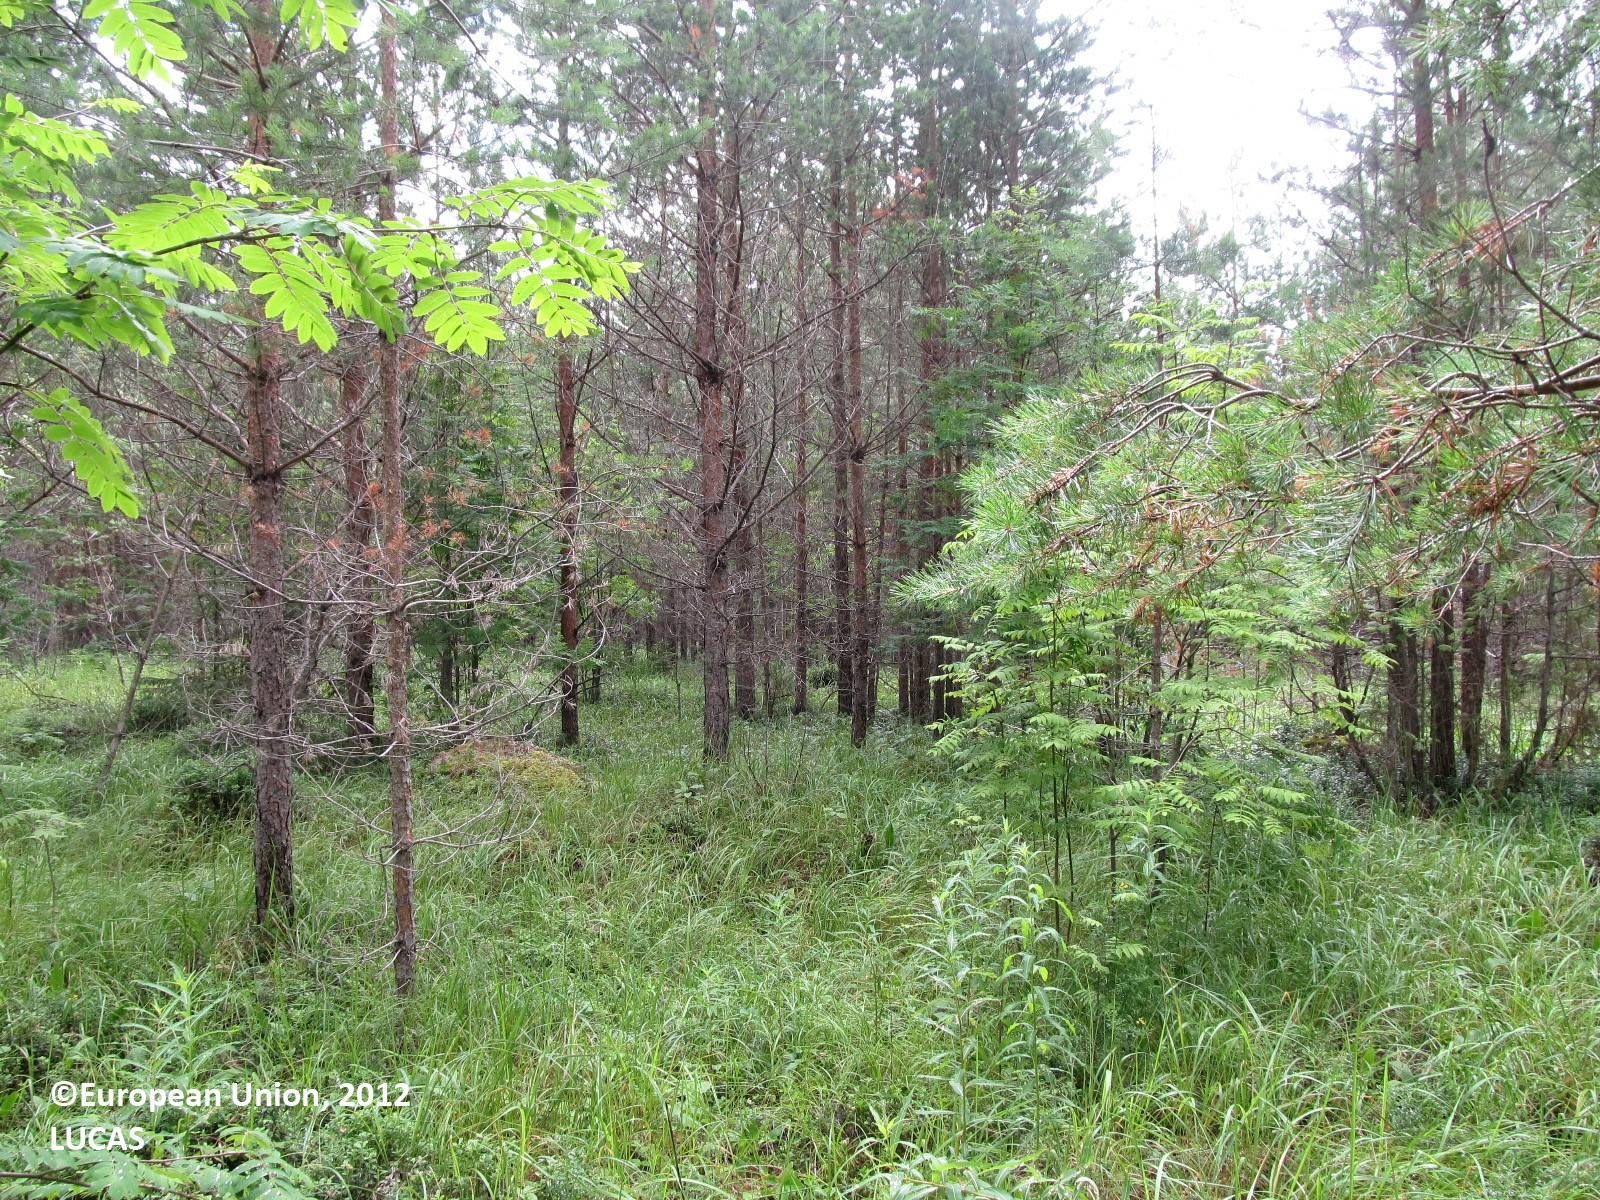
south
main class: Woodland
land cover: Pine dominated coniferous woodland
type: boreal forest
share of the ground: 25 - 50 %
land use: Forestry
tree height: > 5 m
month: July
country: FI
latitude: 61.9382
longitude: 29.0349
